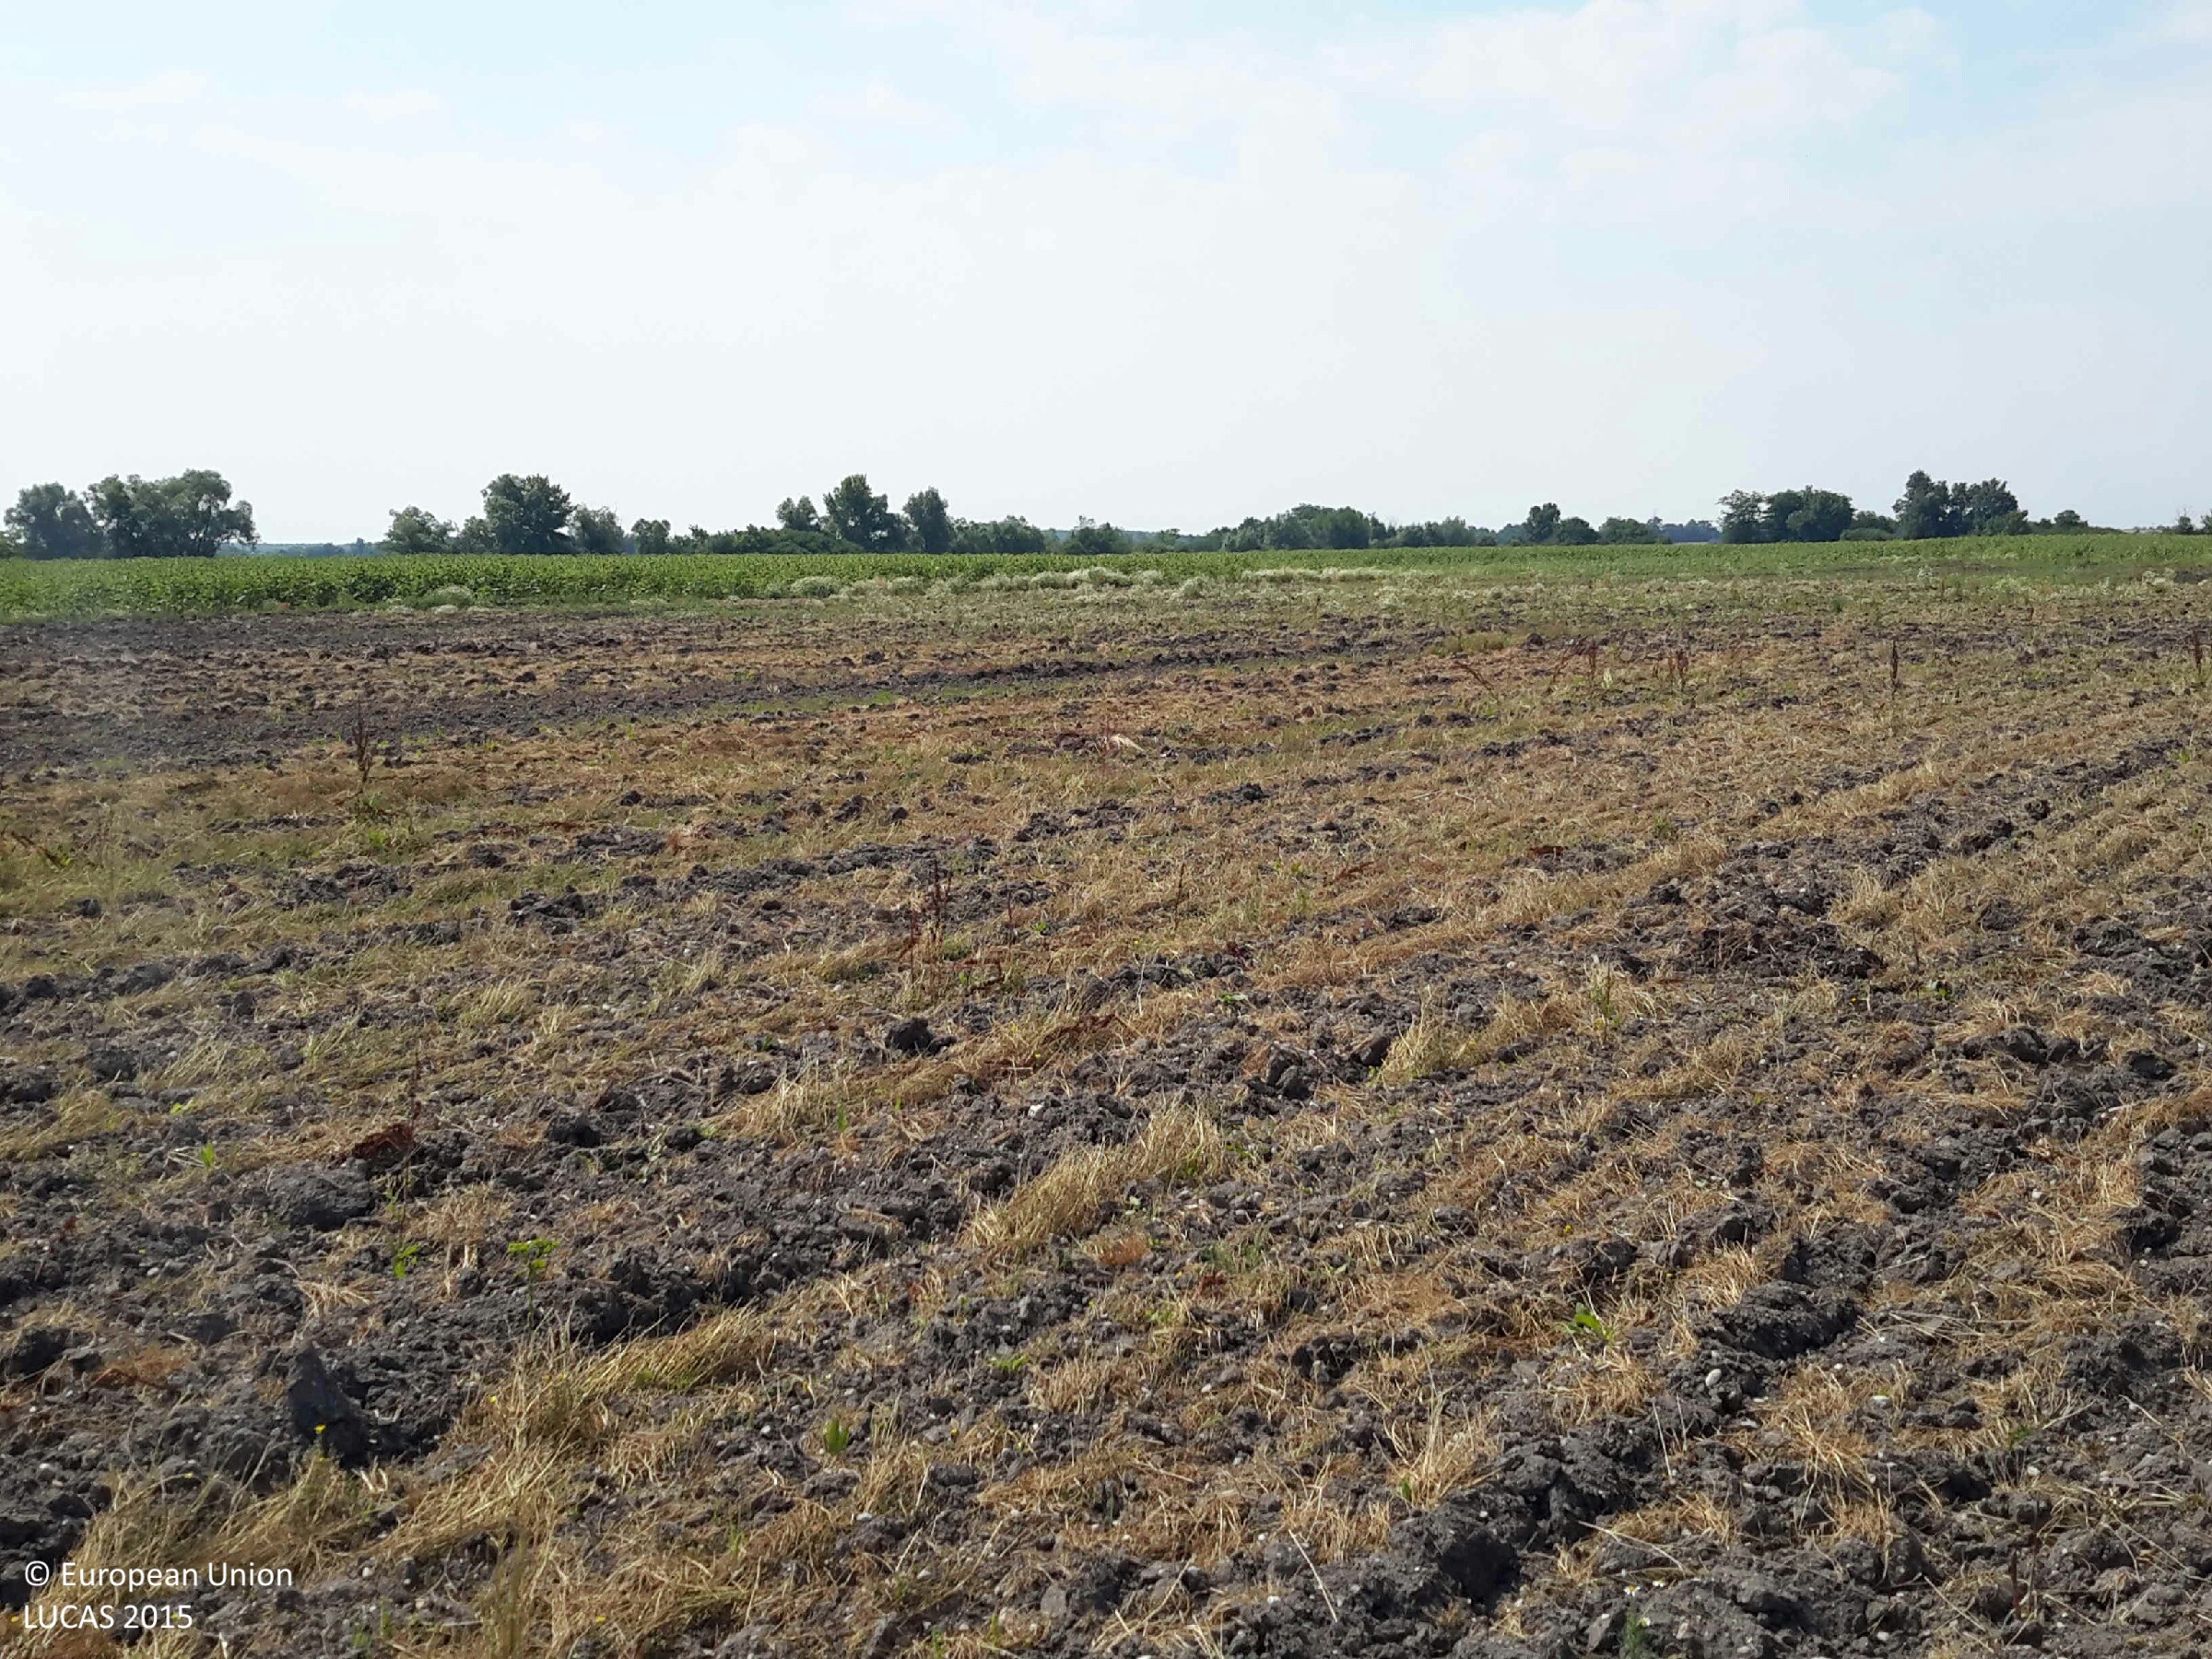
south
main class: Grassland
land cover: Spontaneously vegetated surfaces
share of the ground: 10 - 25 %
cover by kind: unconsolidated bare surface 90 %, herbaceous plants 10 %
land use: Fallow land
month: July
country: HU
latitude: 47.4313
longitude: 17.4186
